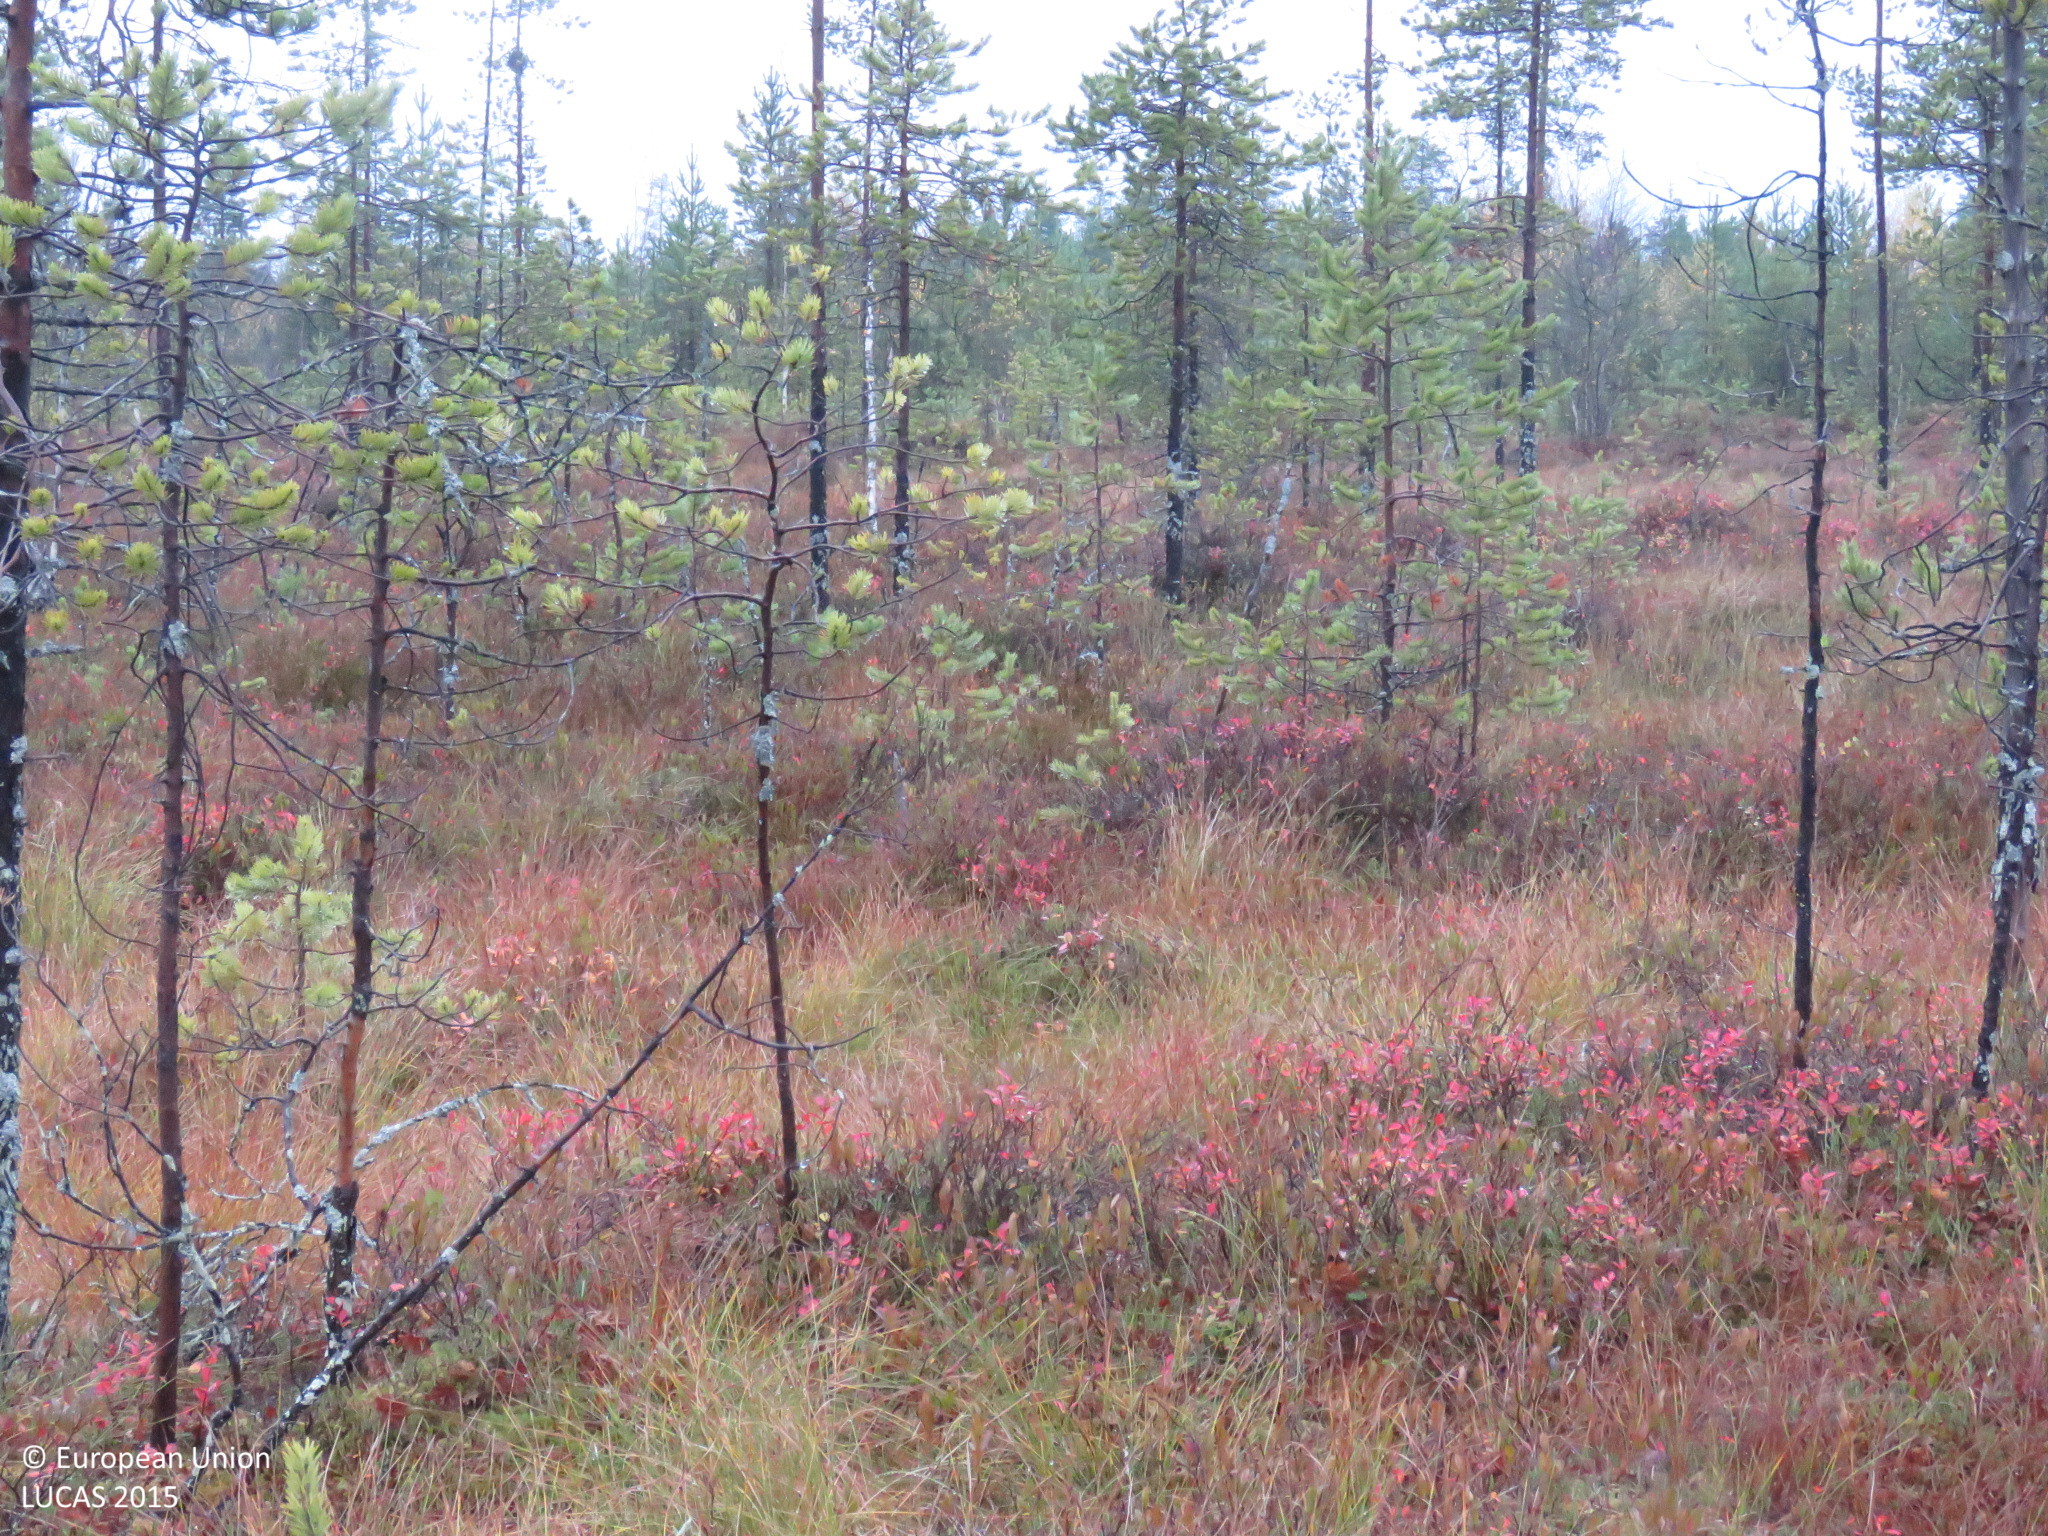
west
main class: Woodland
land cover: Pine dominated coniferous woodland
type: mire and swamp forests
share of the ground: 25 - 50 %
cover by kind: coniferous forest trees 40 %, herbaceous plants 30 %, shrubs 25 %, lichens and mosses 5 %
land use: Semi-natural and natural areas not in use
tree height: < 5 m
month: September
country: FI
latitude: 65.3096
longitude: 27.3562
